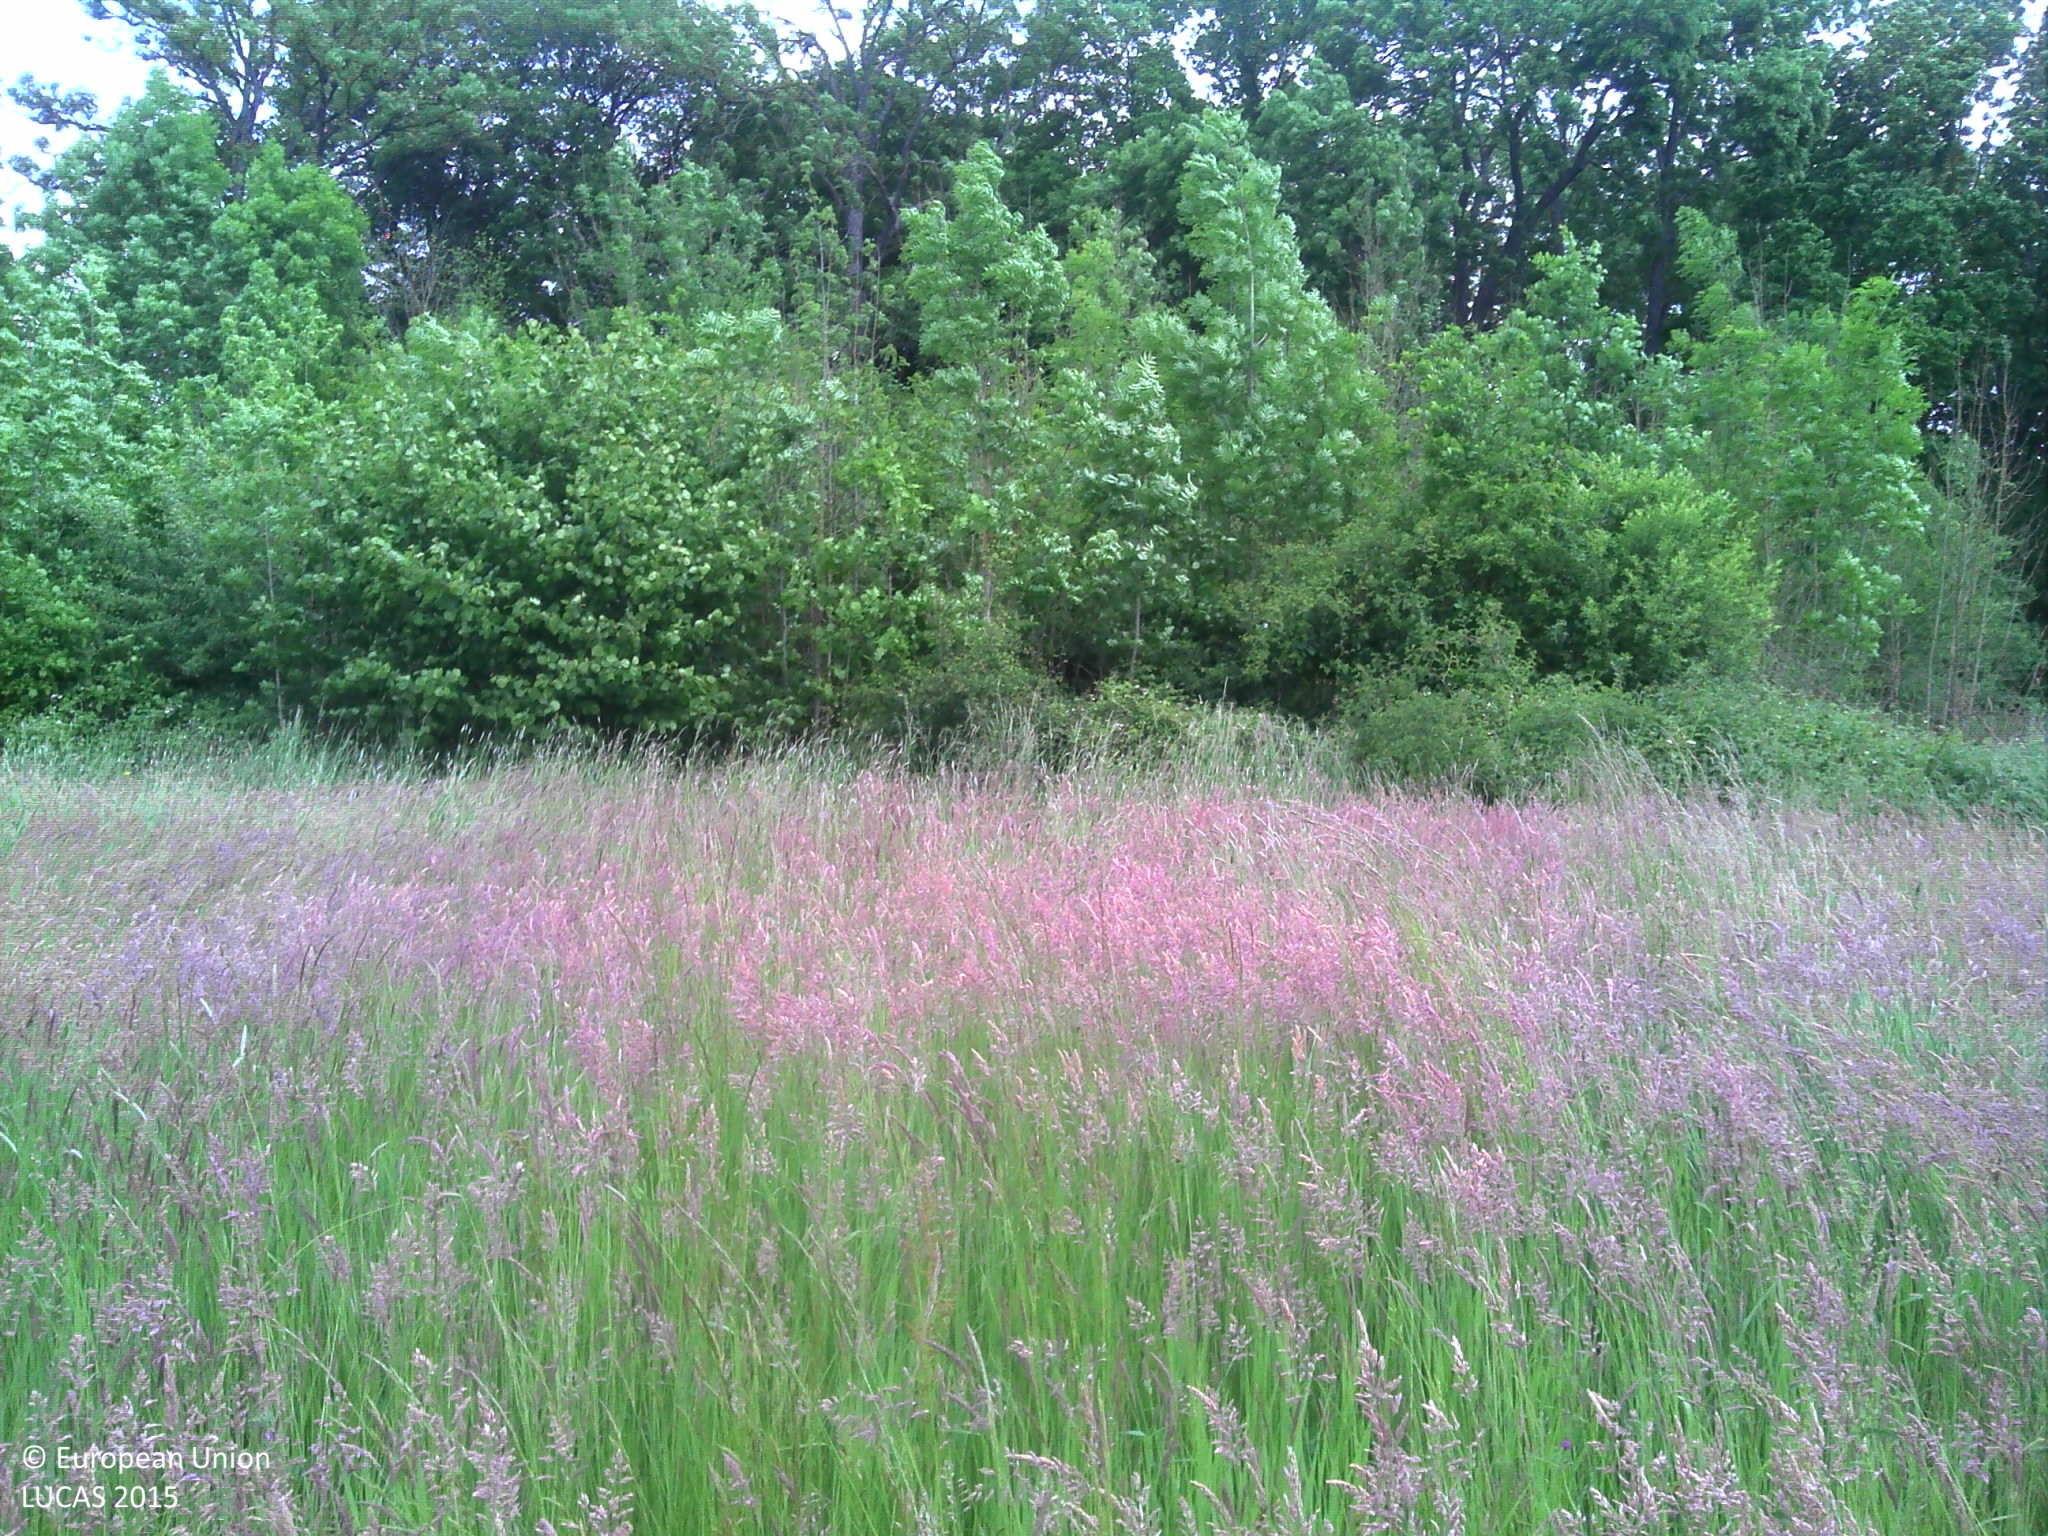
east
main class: Grassland
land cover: Grassland without tree/shrub cover
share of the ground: > 75 %
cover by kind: herbaceous plants 100 %
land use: Agriculture (excluding fallow land and kitchen gardens)
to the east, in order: Grassland without tree/shrub cover; Broadleaved woodland; Grass margins; Paved roads, cycling and walking lanes; Lines of trees; Ditches and canals; Broadleaved woodland; Fences; Grassland without tree/shrub cover; Fences; Rivers and streams; Broadleaved woodland
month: May
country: BE
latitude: 50.1751
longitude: 4.8300
